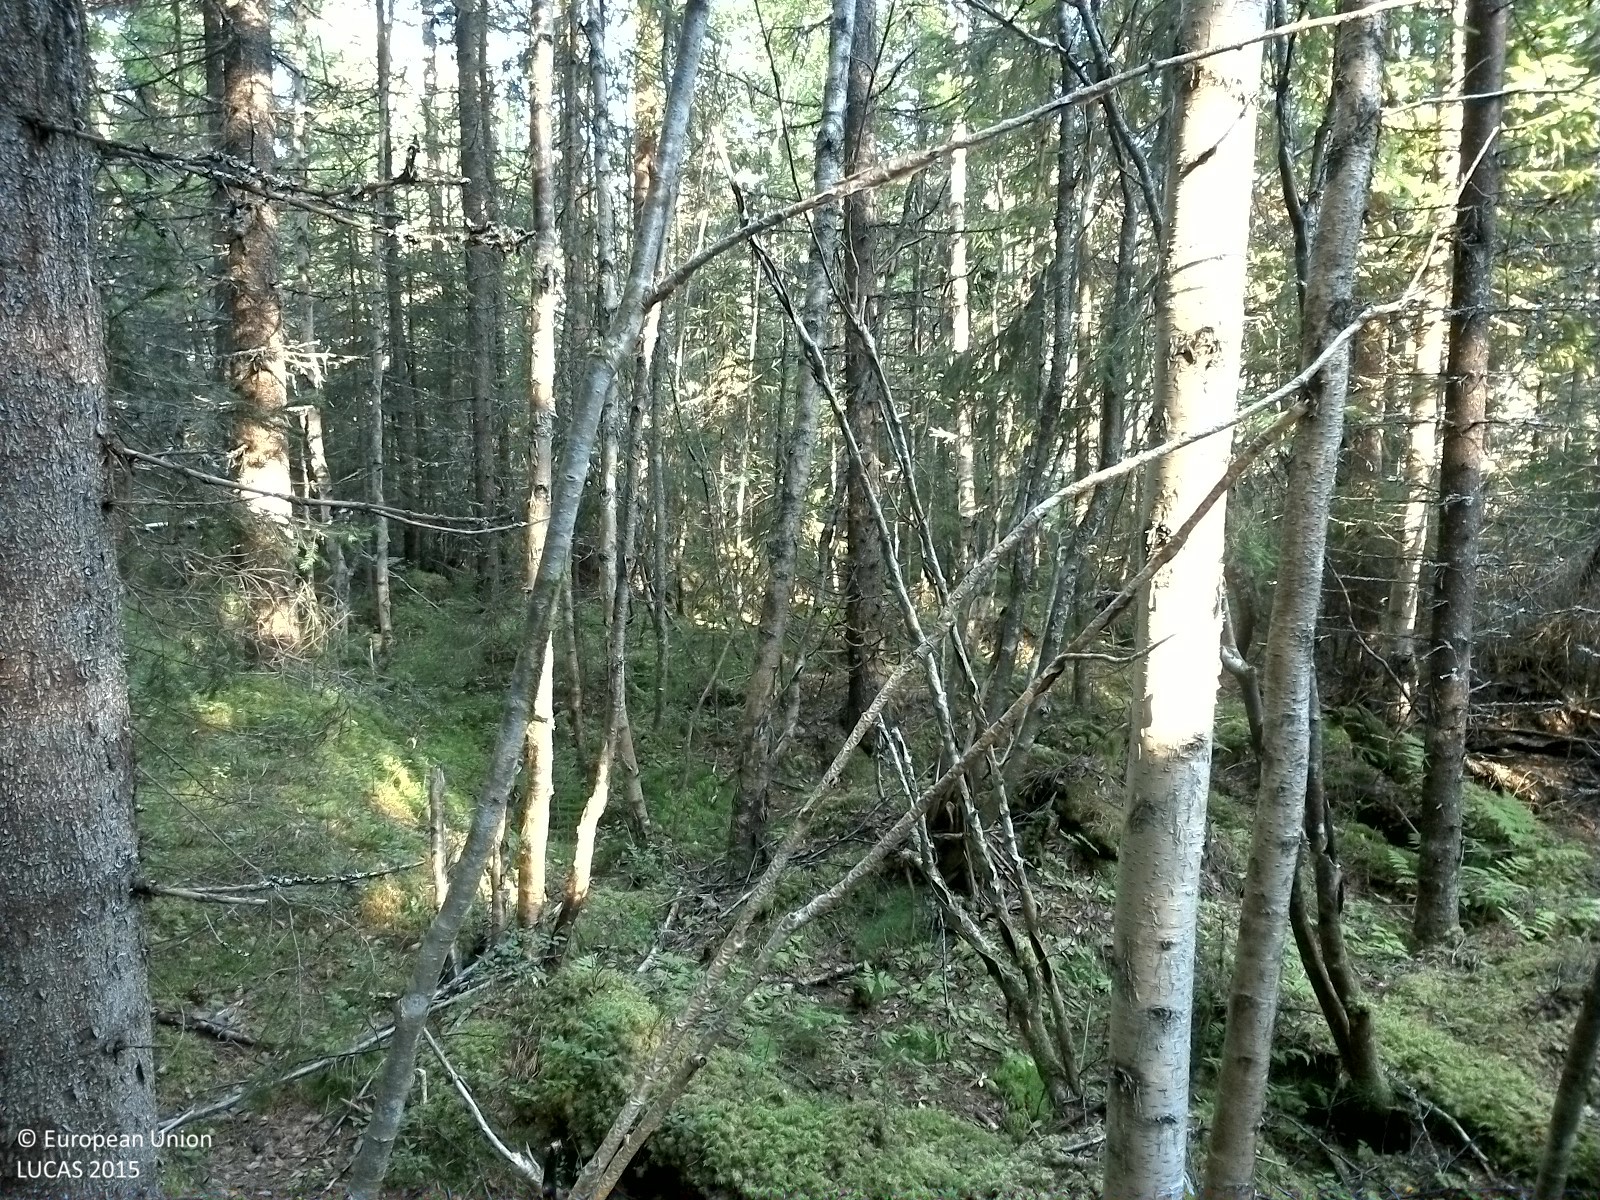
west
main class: Woodland
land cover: Spruce dominated mixed woodland
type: boreal forest
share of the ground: > 75 %
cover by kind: coniferous forest trees 60 %, broadleaved forest trees 20 %, lichens and mosses 20 %
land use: Forestry
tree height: > 5 m
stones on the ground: < 10 %
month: August
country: SE
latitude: 62.3143
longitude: 16.7906
